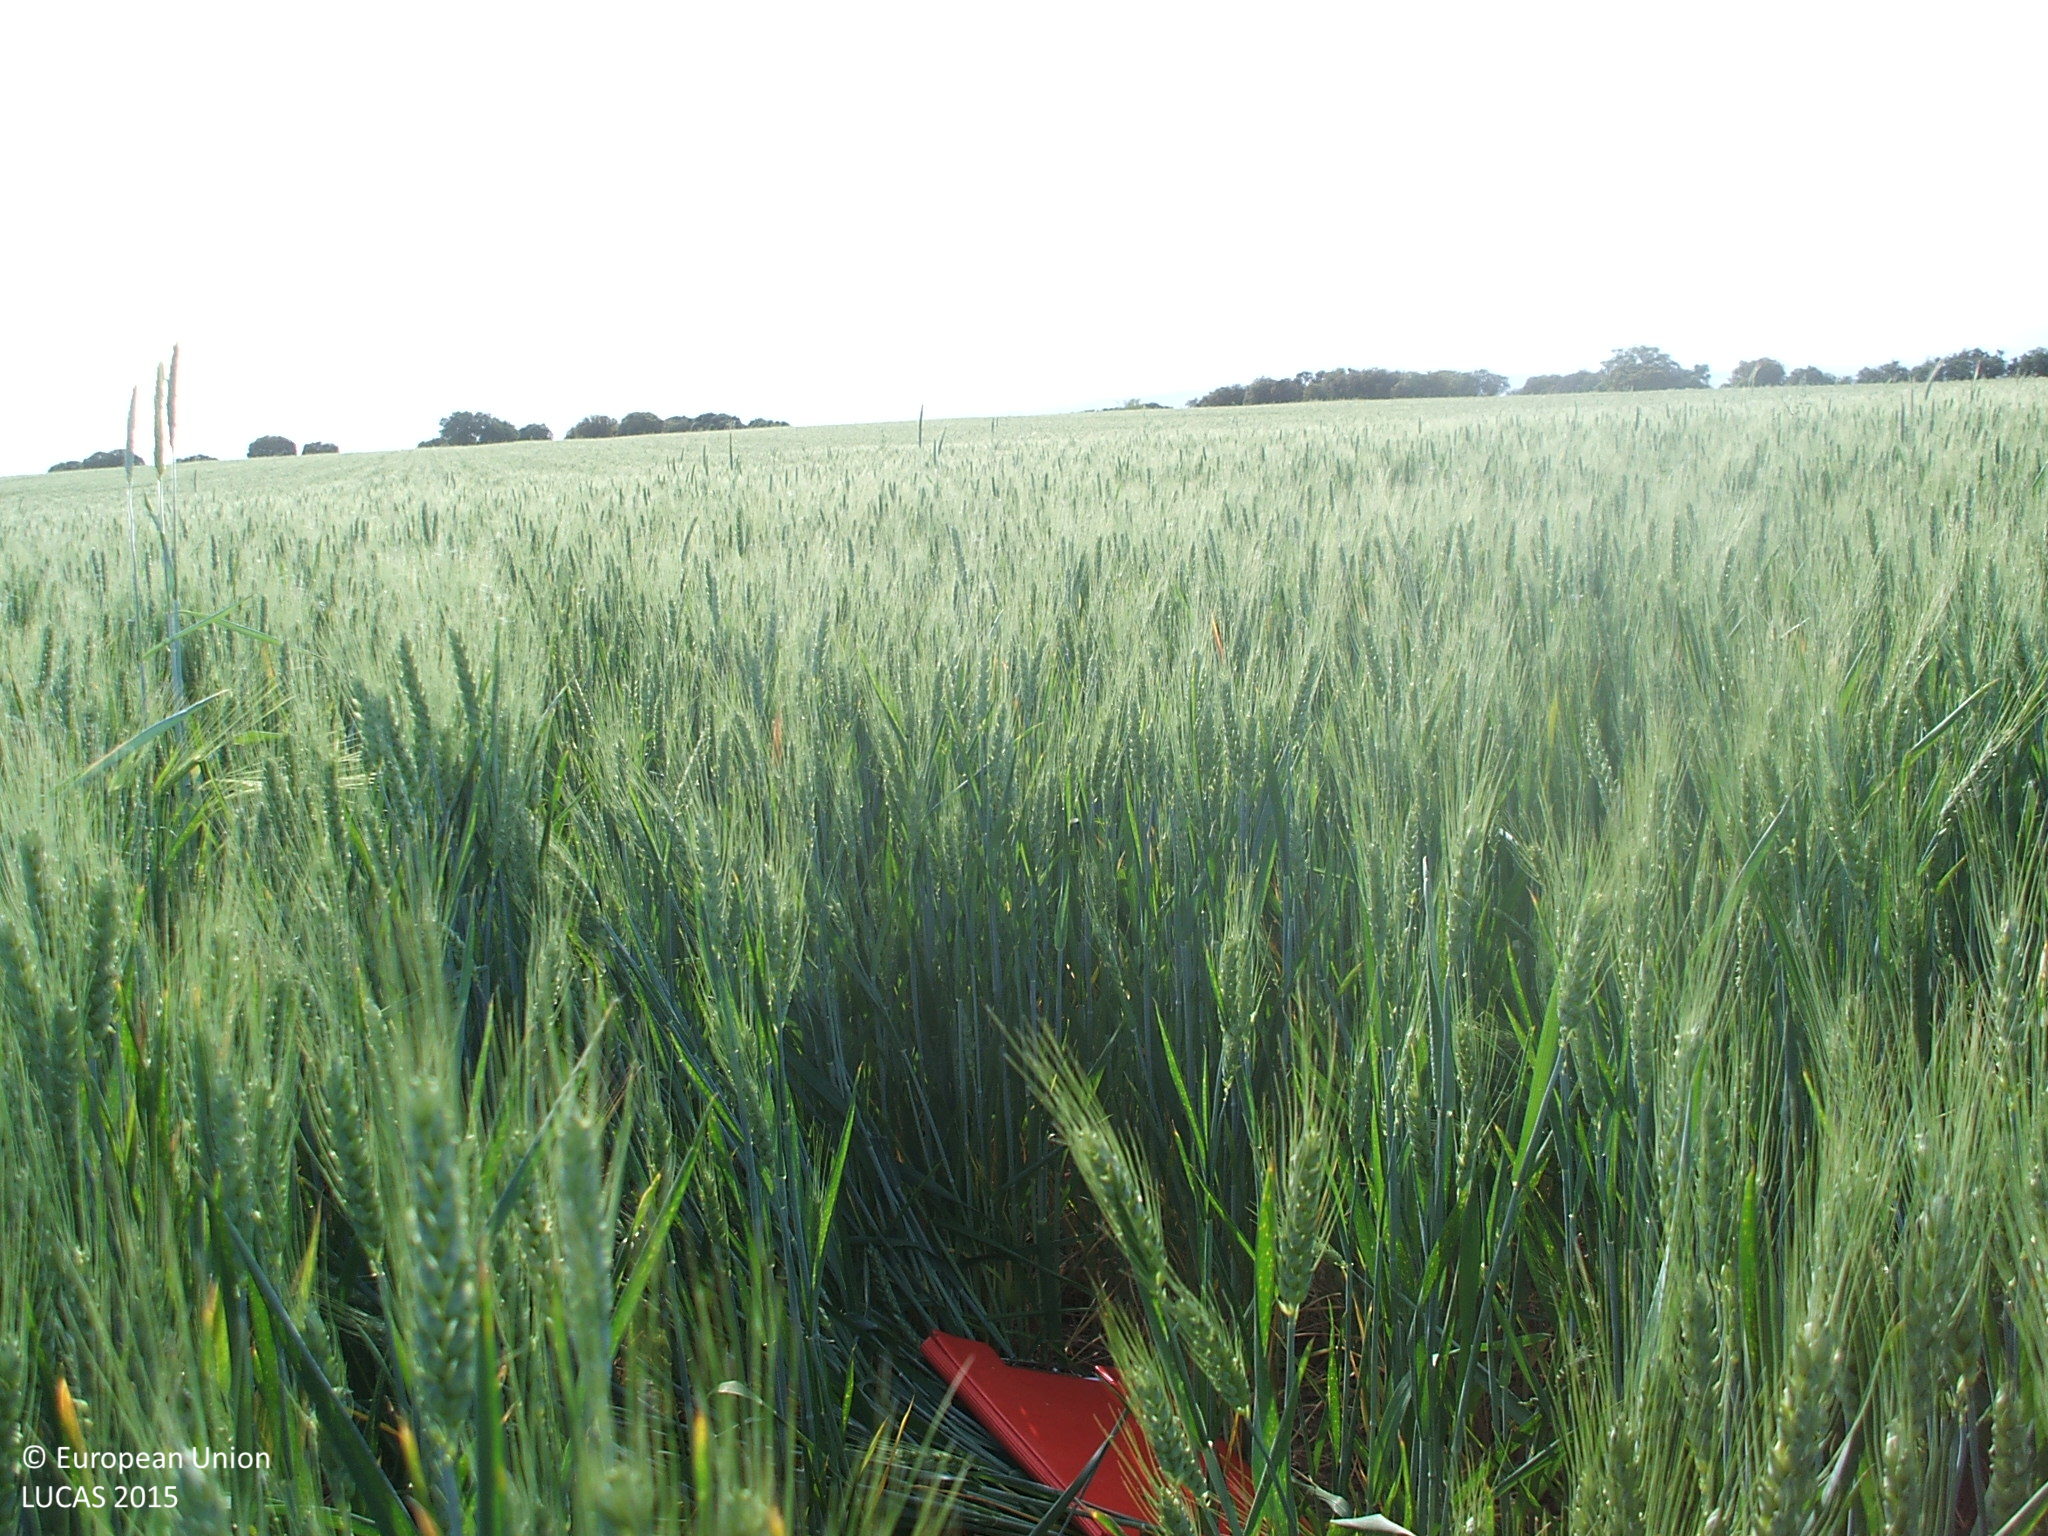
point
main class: Cropland
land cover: Common wheat
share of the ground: > 75 %
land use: Agriculture (excluding fallow land and kitchen gardens)
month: May
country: ES
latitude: 40.7308
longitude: -3.4295
